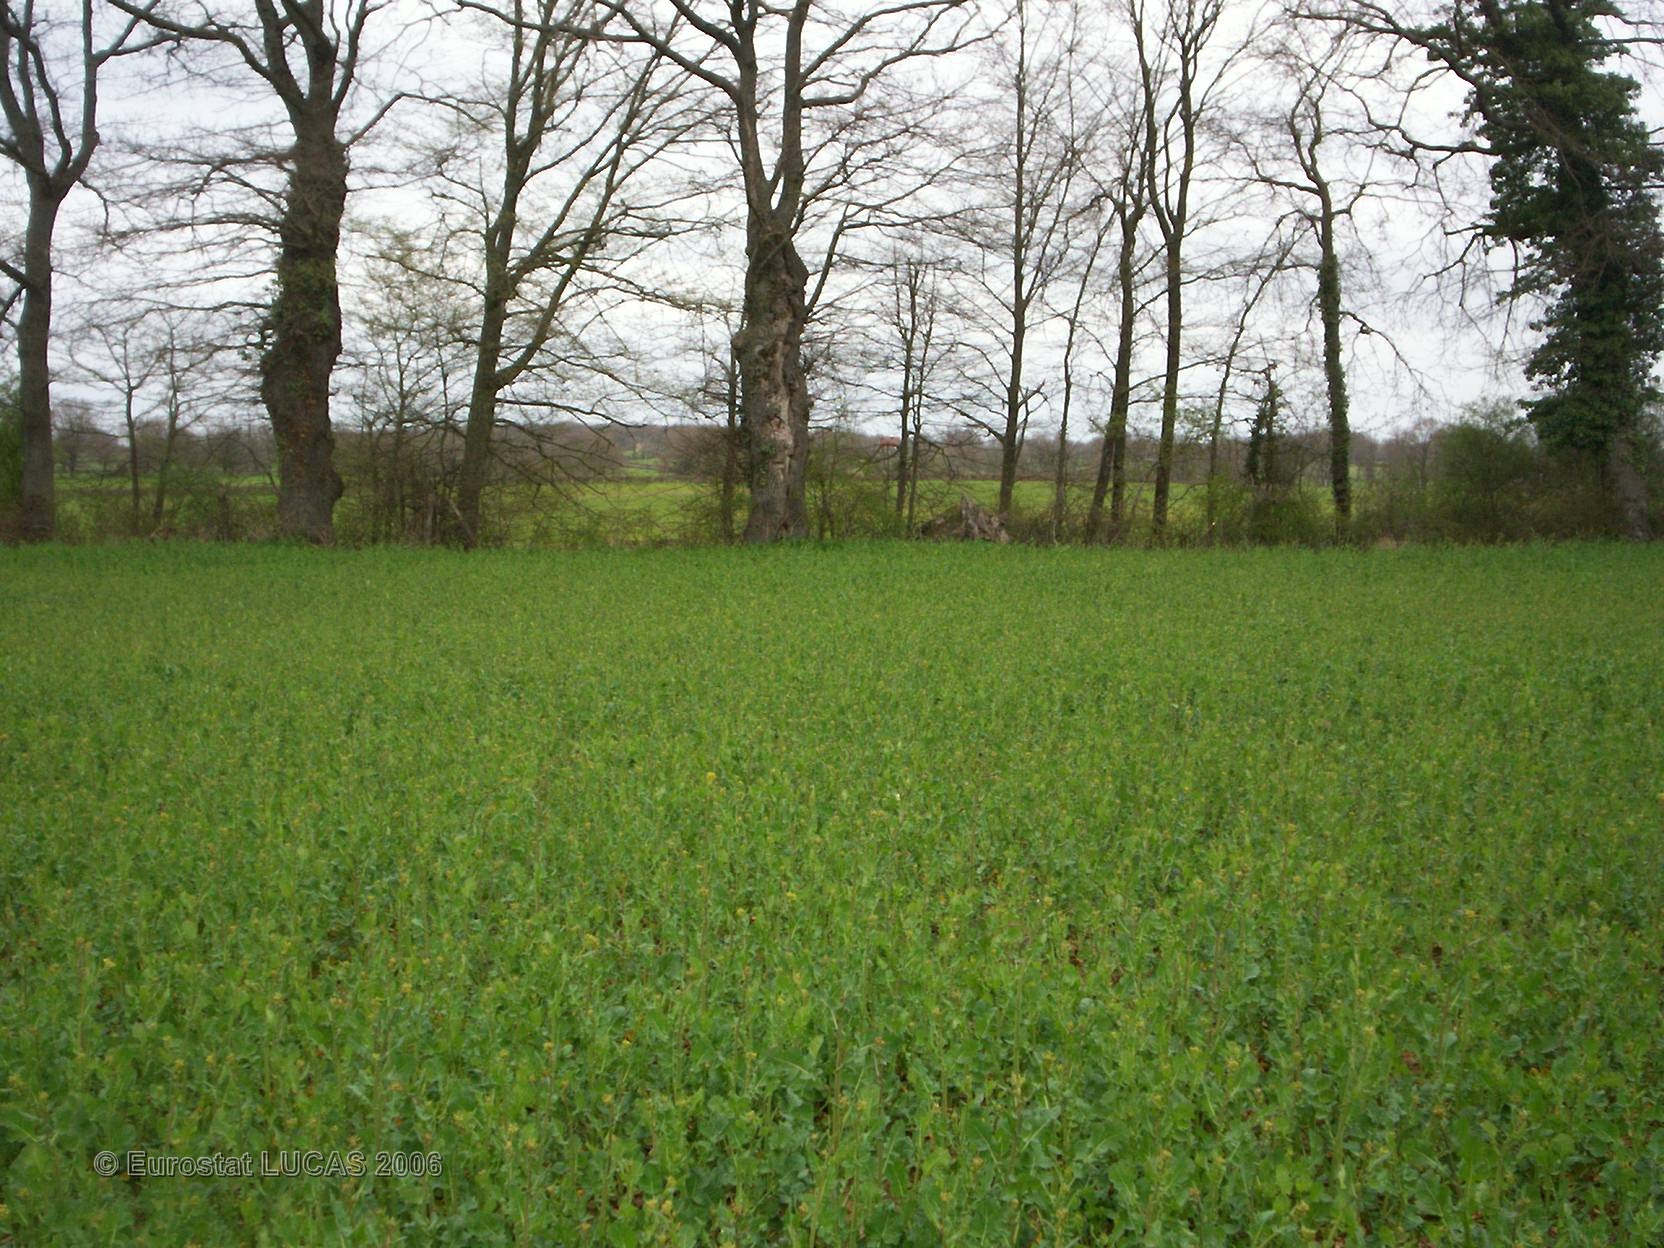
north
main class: Cropland
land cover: Rape and turnip rape
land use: Agriculture (excluding fallow land and kitchen gardens)
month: April
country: FR
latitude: 46.7035
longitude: 3.0517
